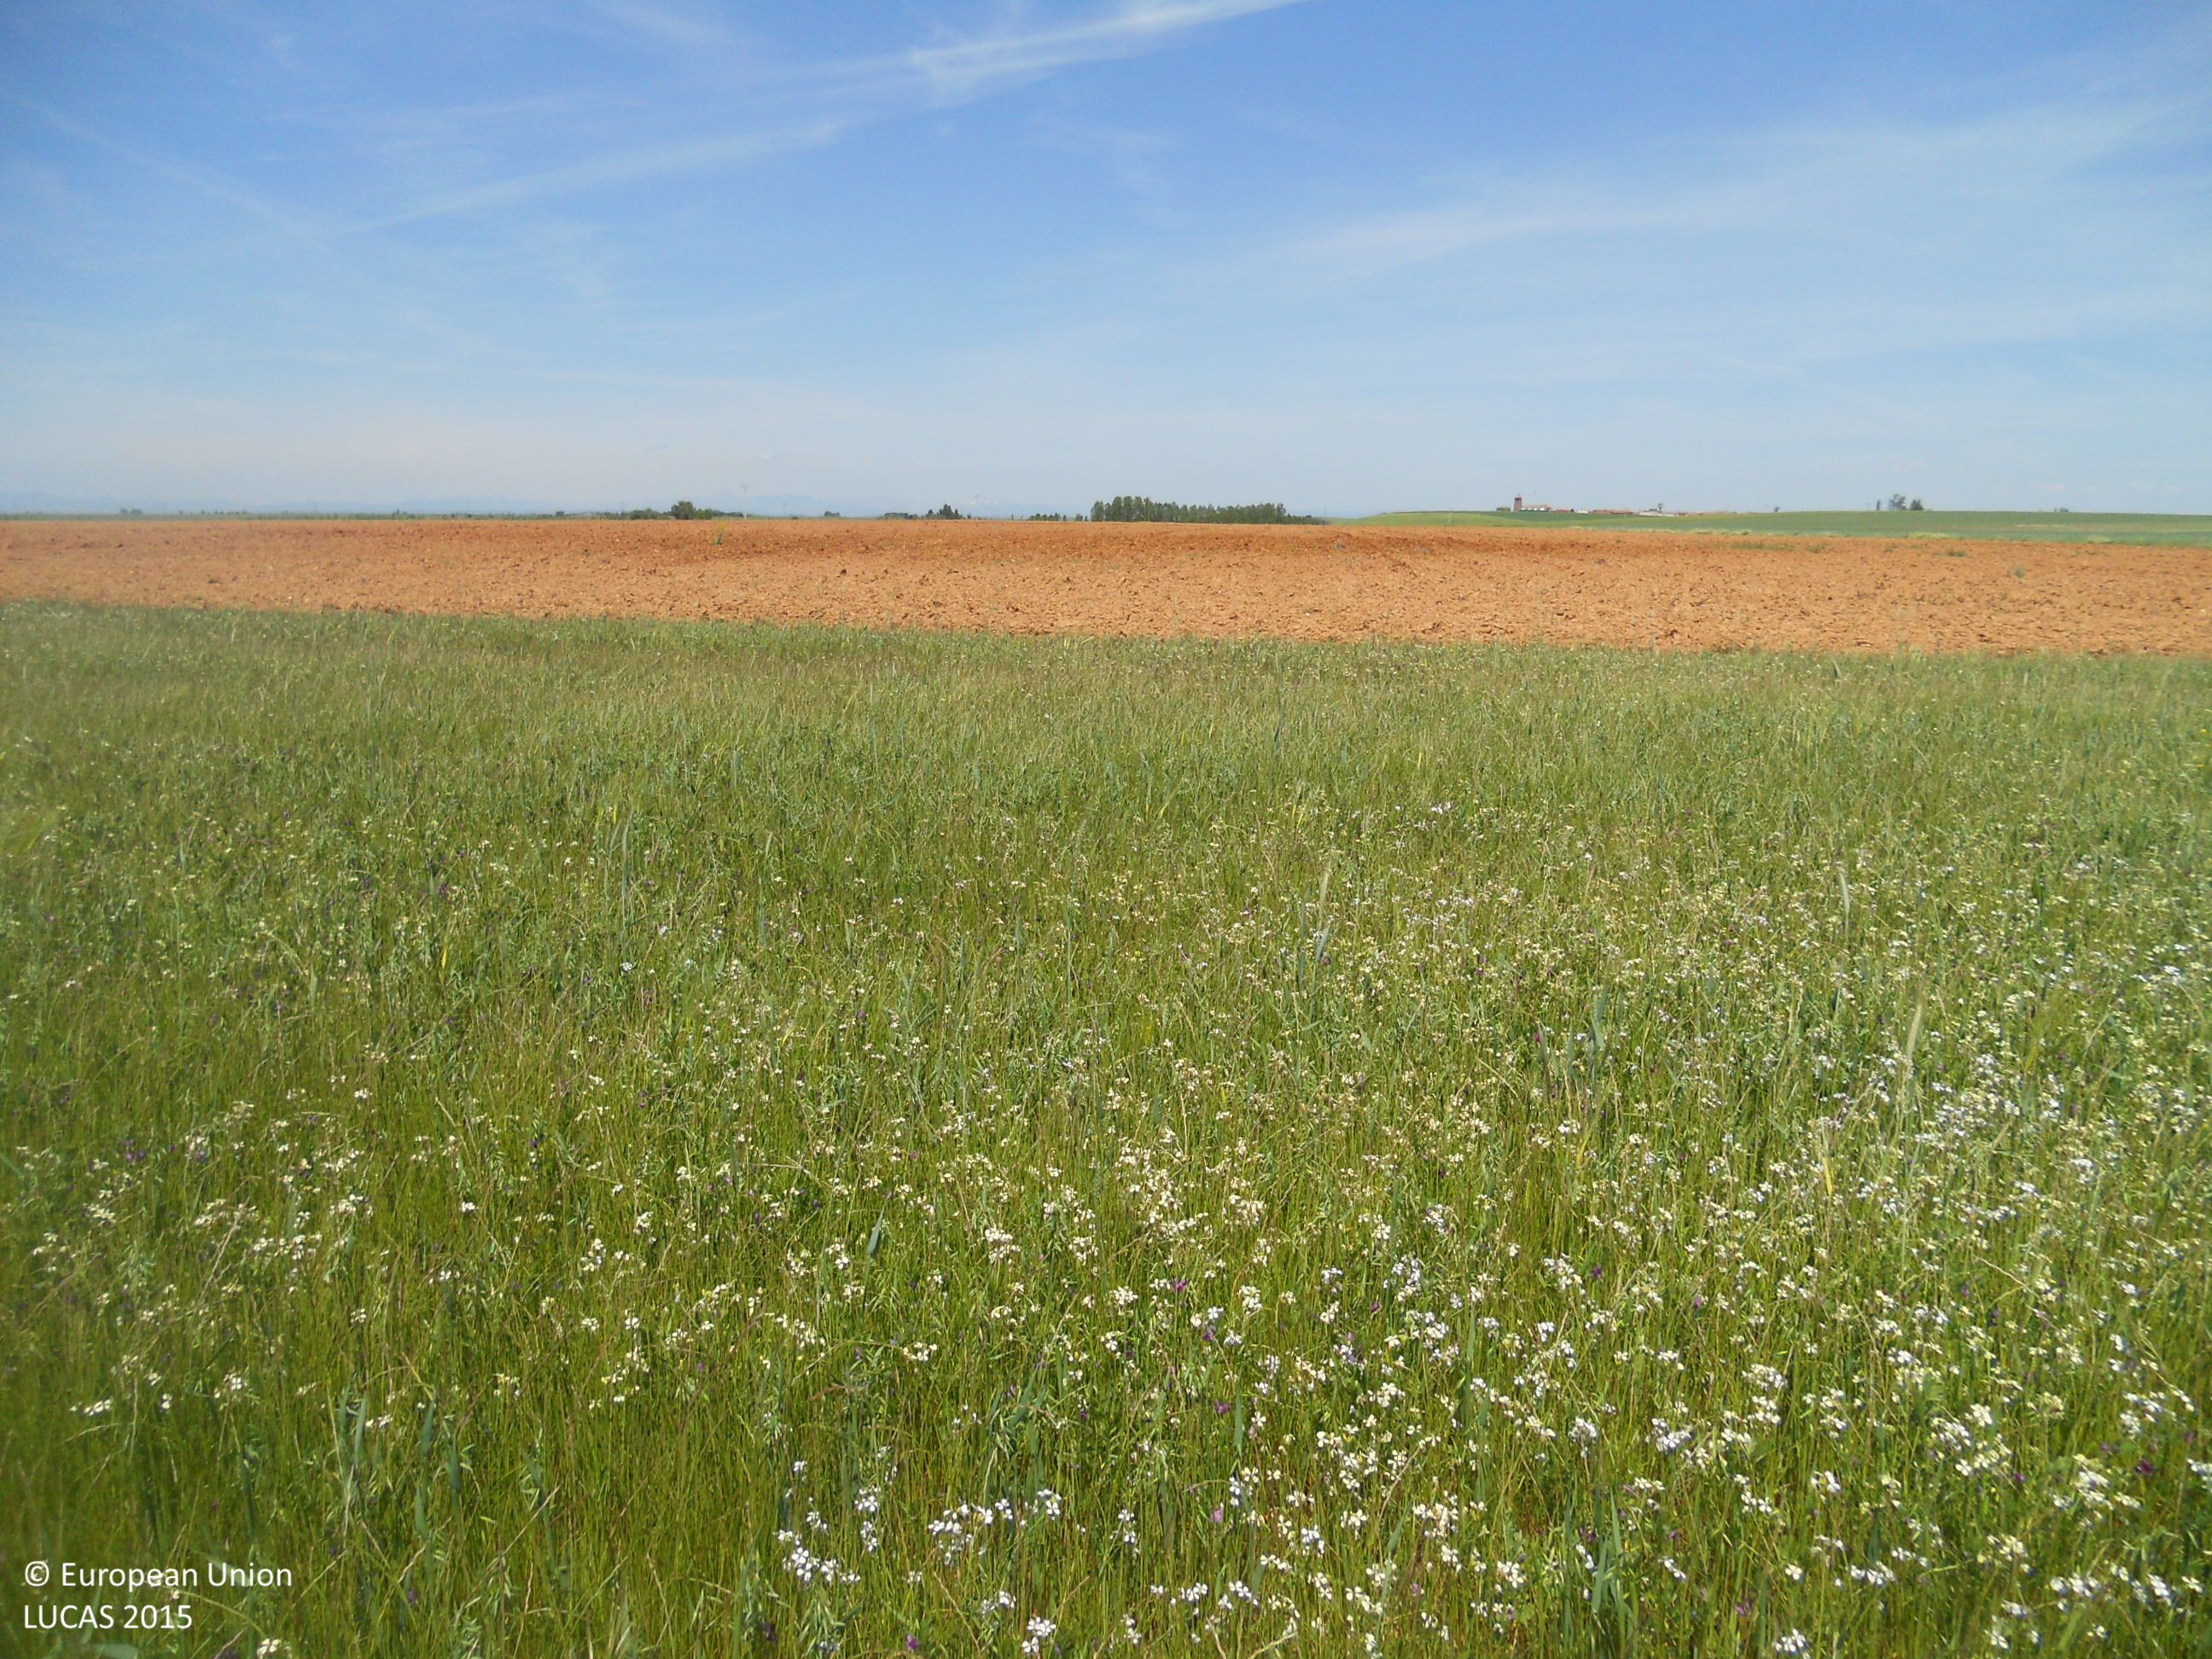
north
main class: Cropland
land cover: Mixed cereals for fodder
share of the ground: > 75 %
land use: Agriculture (excluding fallow land and kitchen gardens)
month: May
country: ES
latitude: 42.3815
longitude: -5.3076
